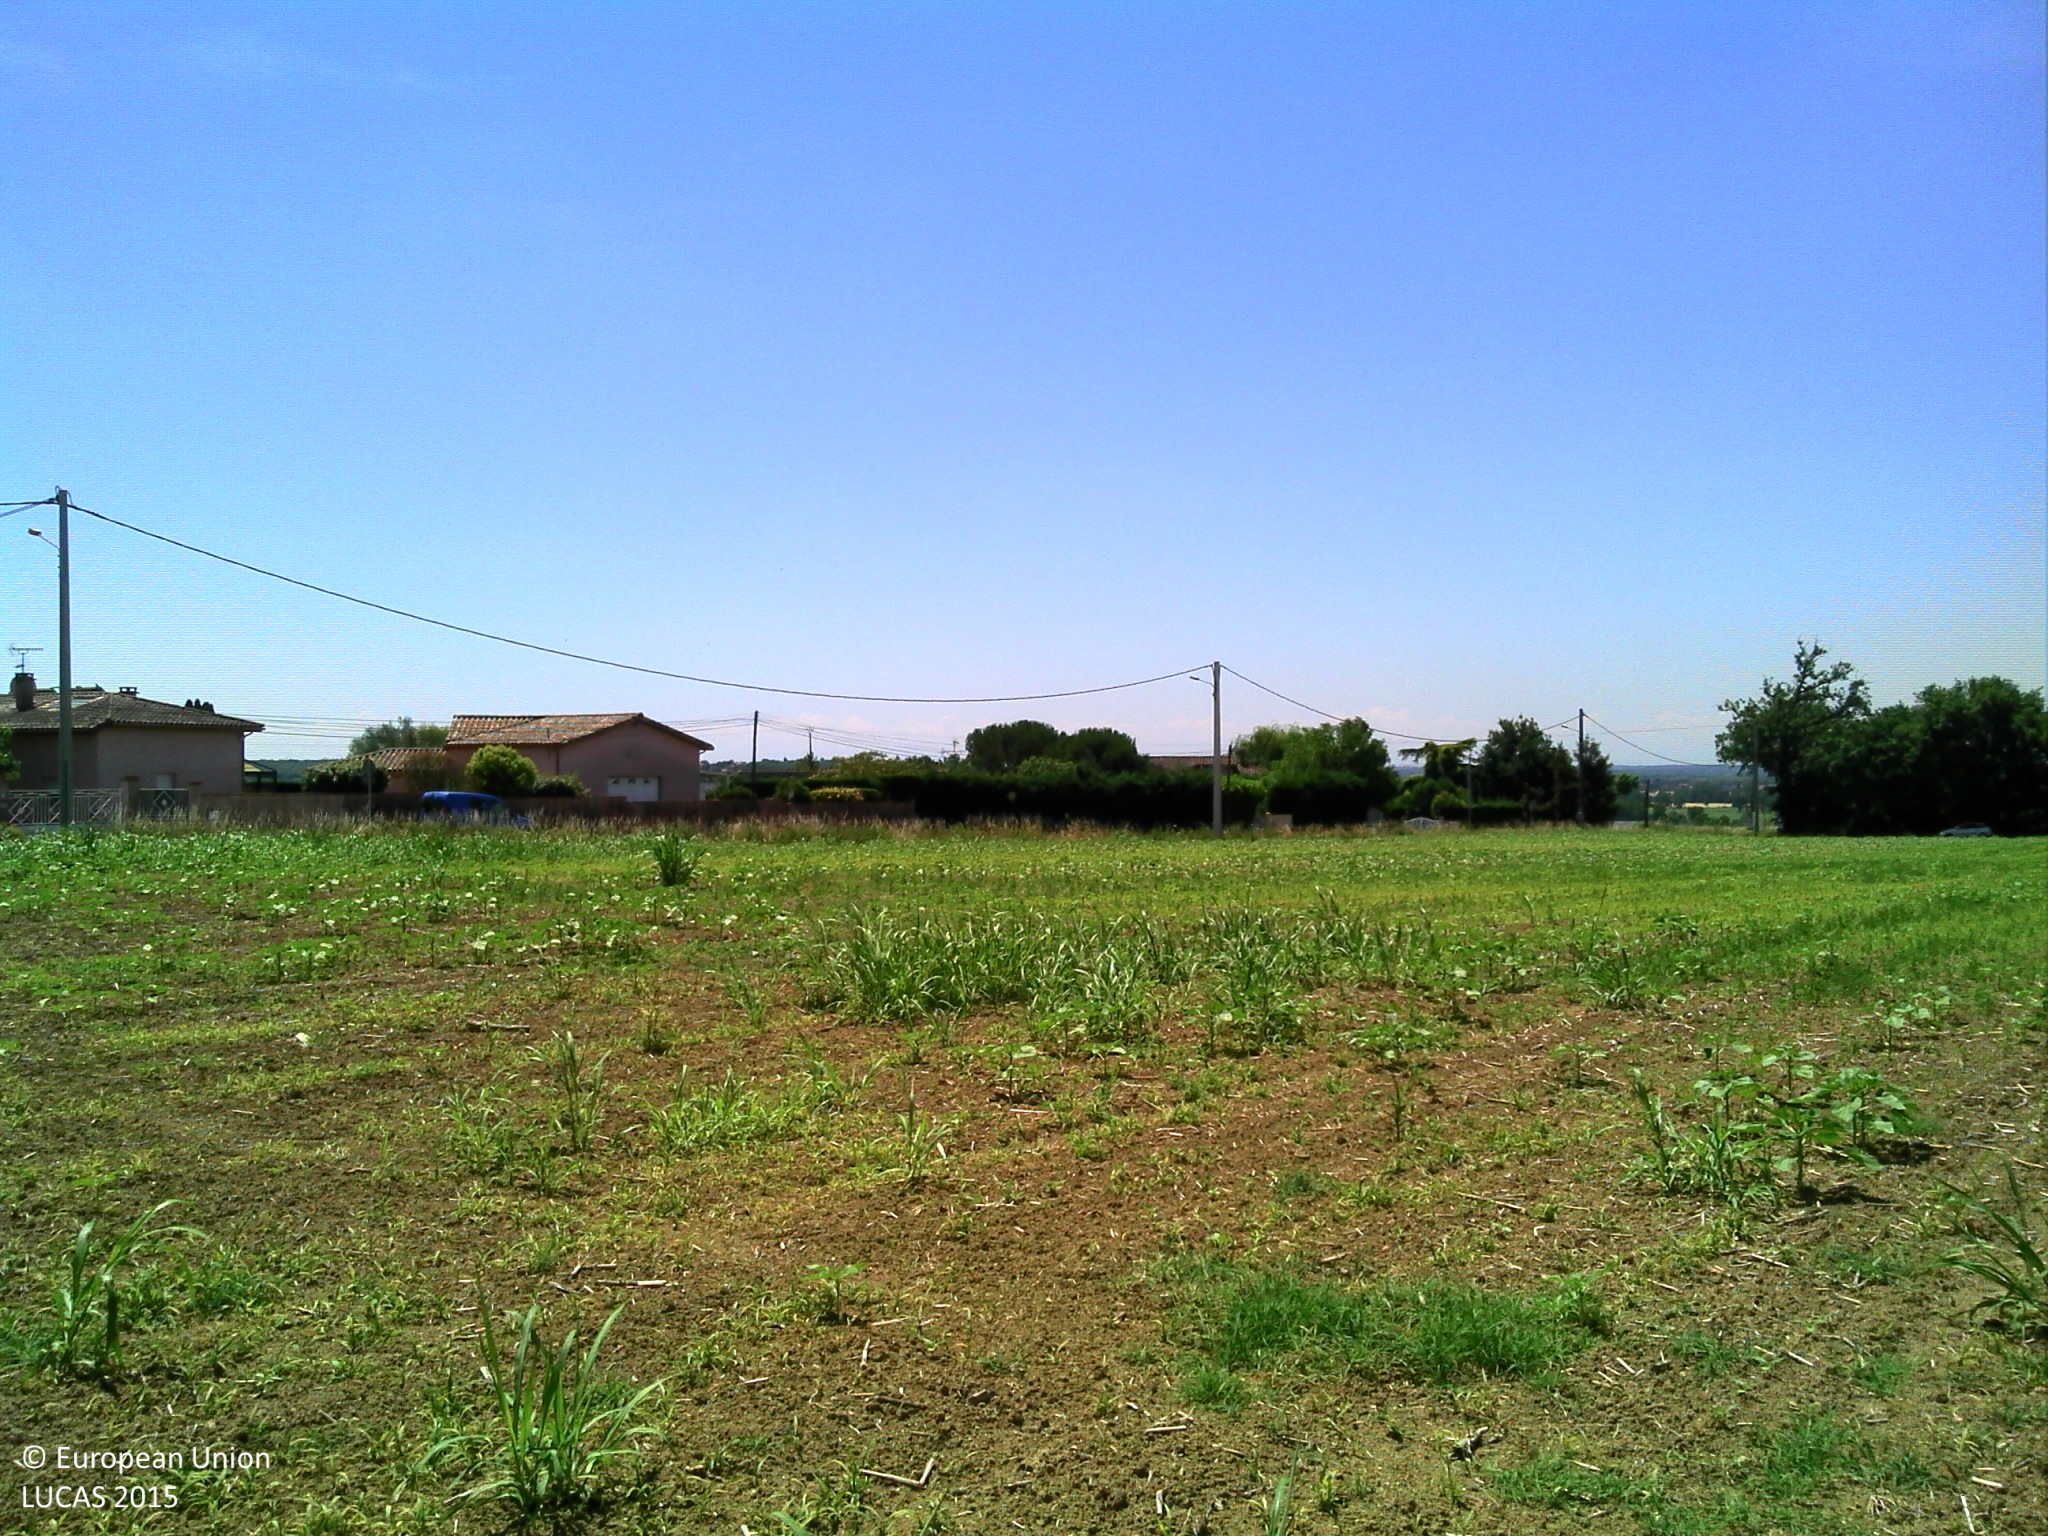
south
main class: Grassland
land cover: Spontaneously vegetated surfaces
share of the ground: 50 - 75 %
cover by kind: herbaceous plants 55 %, unconsolidated bare surface 45 %
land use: Agriculture (excluding fallow land and kitchen gardens)
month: June
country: FR
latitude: 43.7747
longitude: 1.3916
